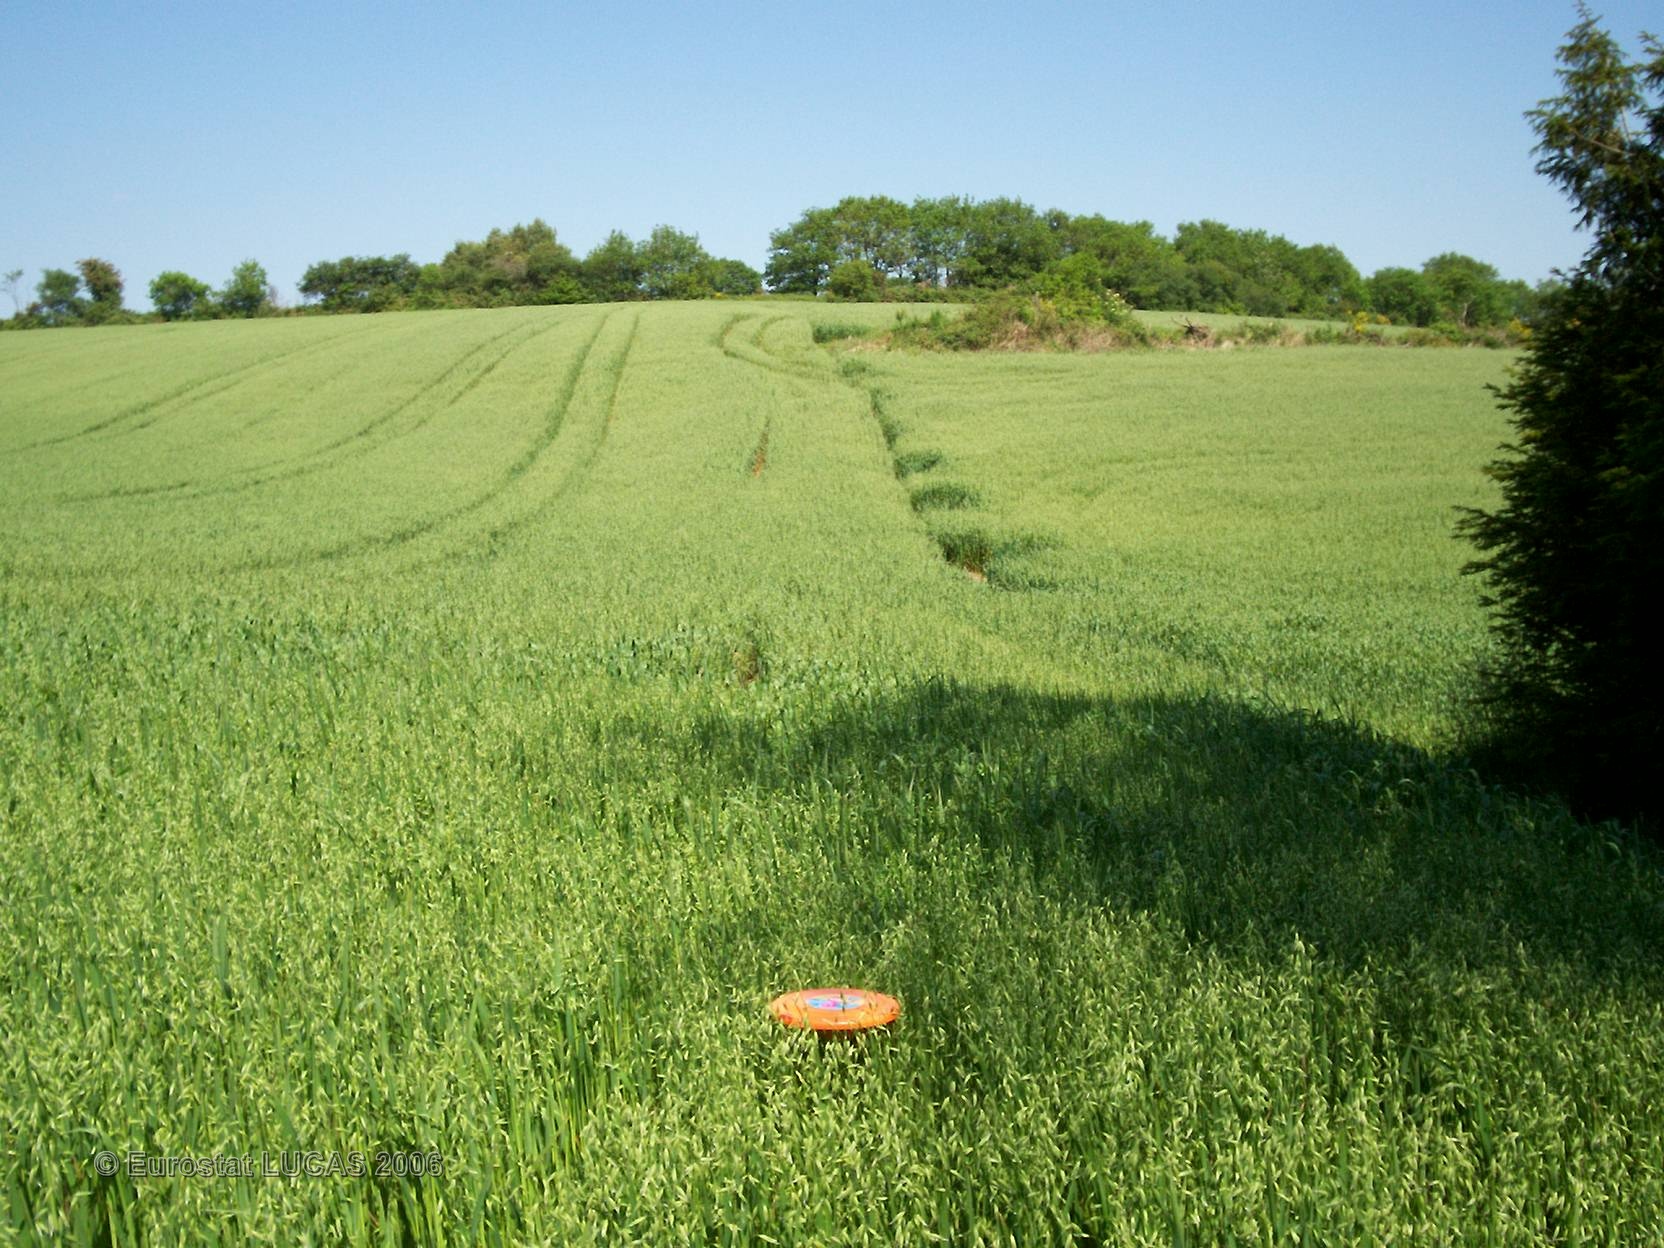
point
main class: Cropland
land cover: Oats
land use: Agriculture (excluding fallow land and kitchen gardens)
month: June
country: FR
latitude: 48.2944
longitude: -3.9846
